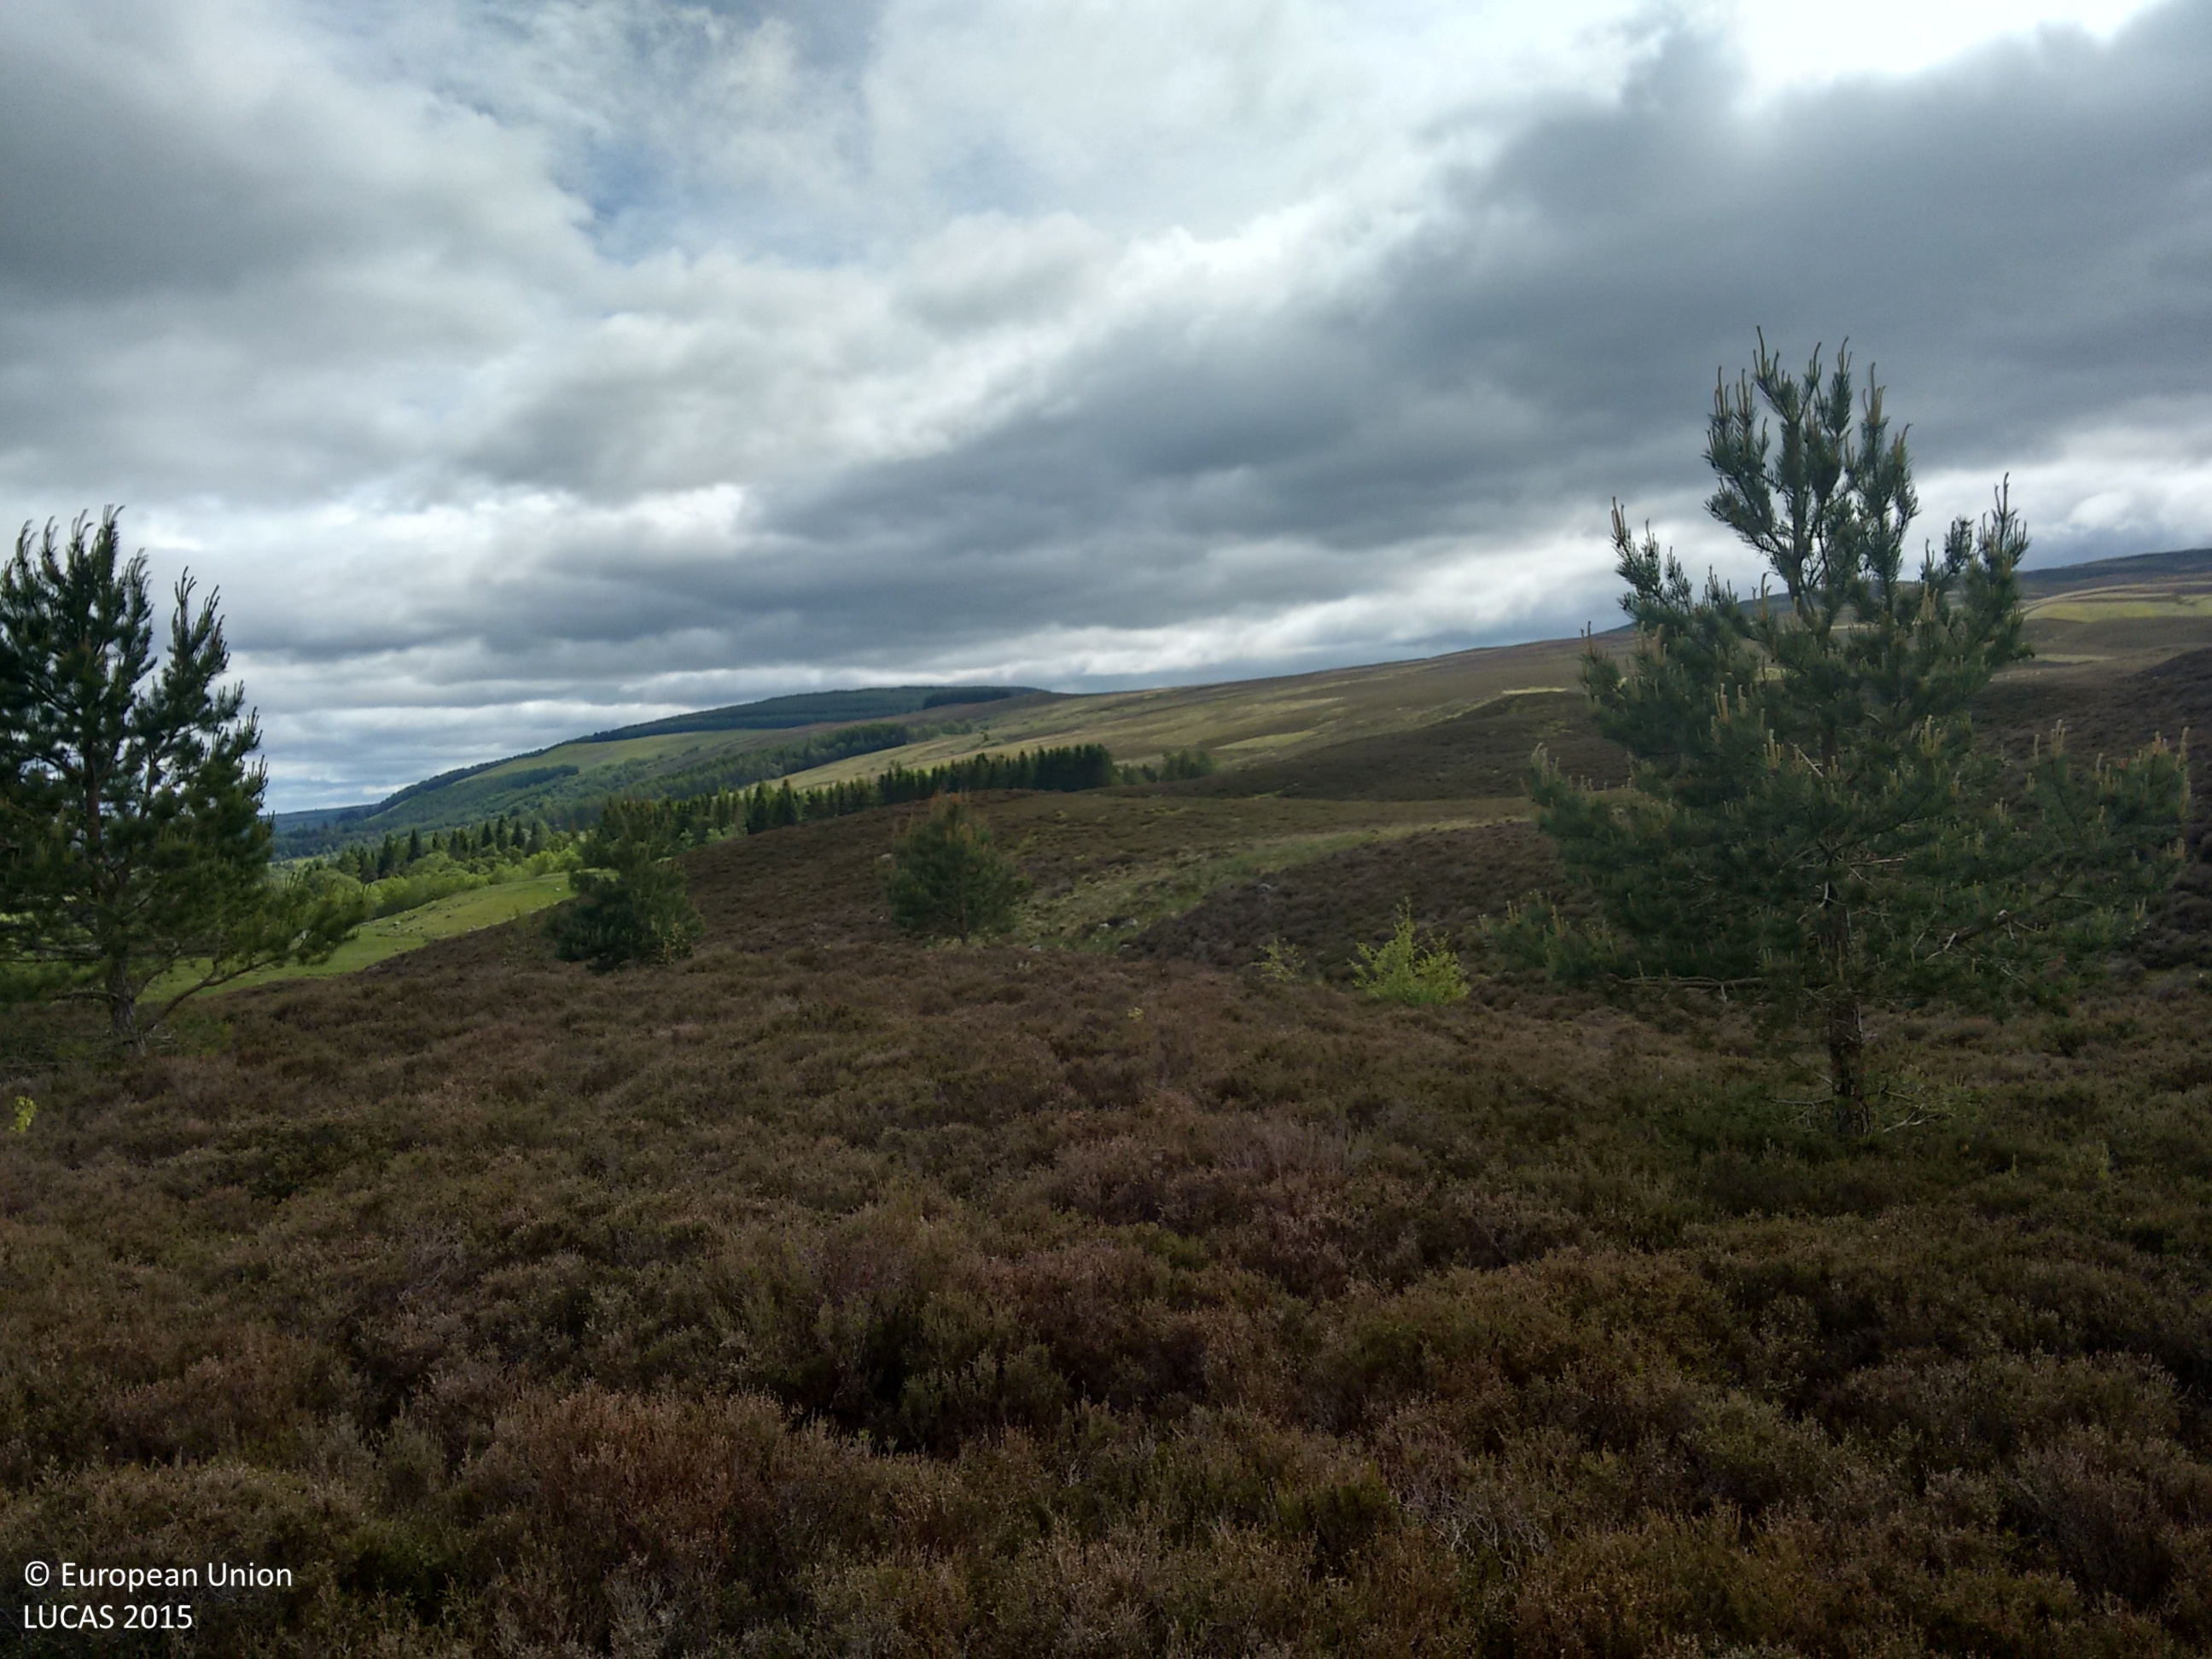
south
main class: Shrubland
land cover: Shrubland without tree cover
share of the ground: > 75 %
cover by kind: shrubs 95 %, herbaceous plants 5 %
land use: Agriculture (excluding fallow land and kitchen gardens)
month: June
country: GB
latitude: 56.6922
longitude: -3.5125
